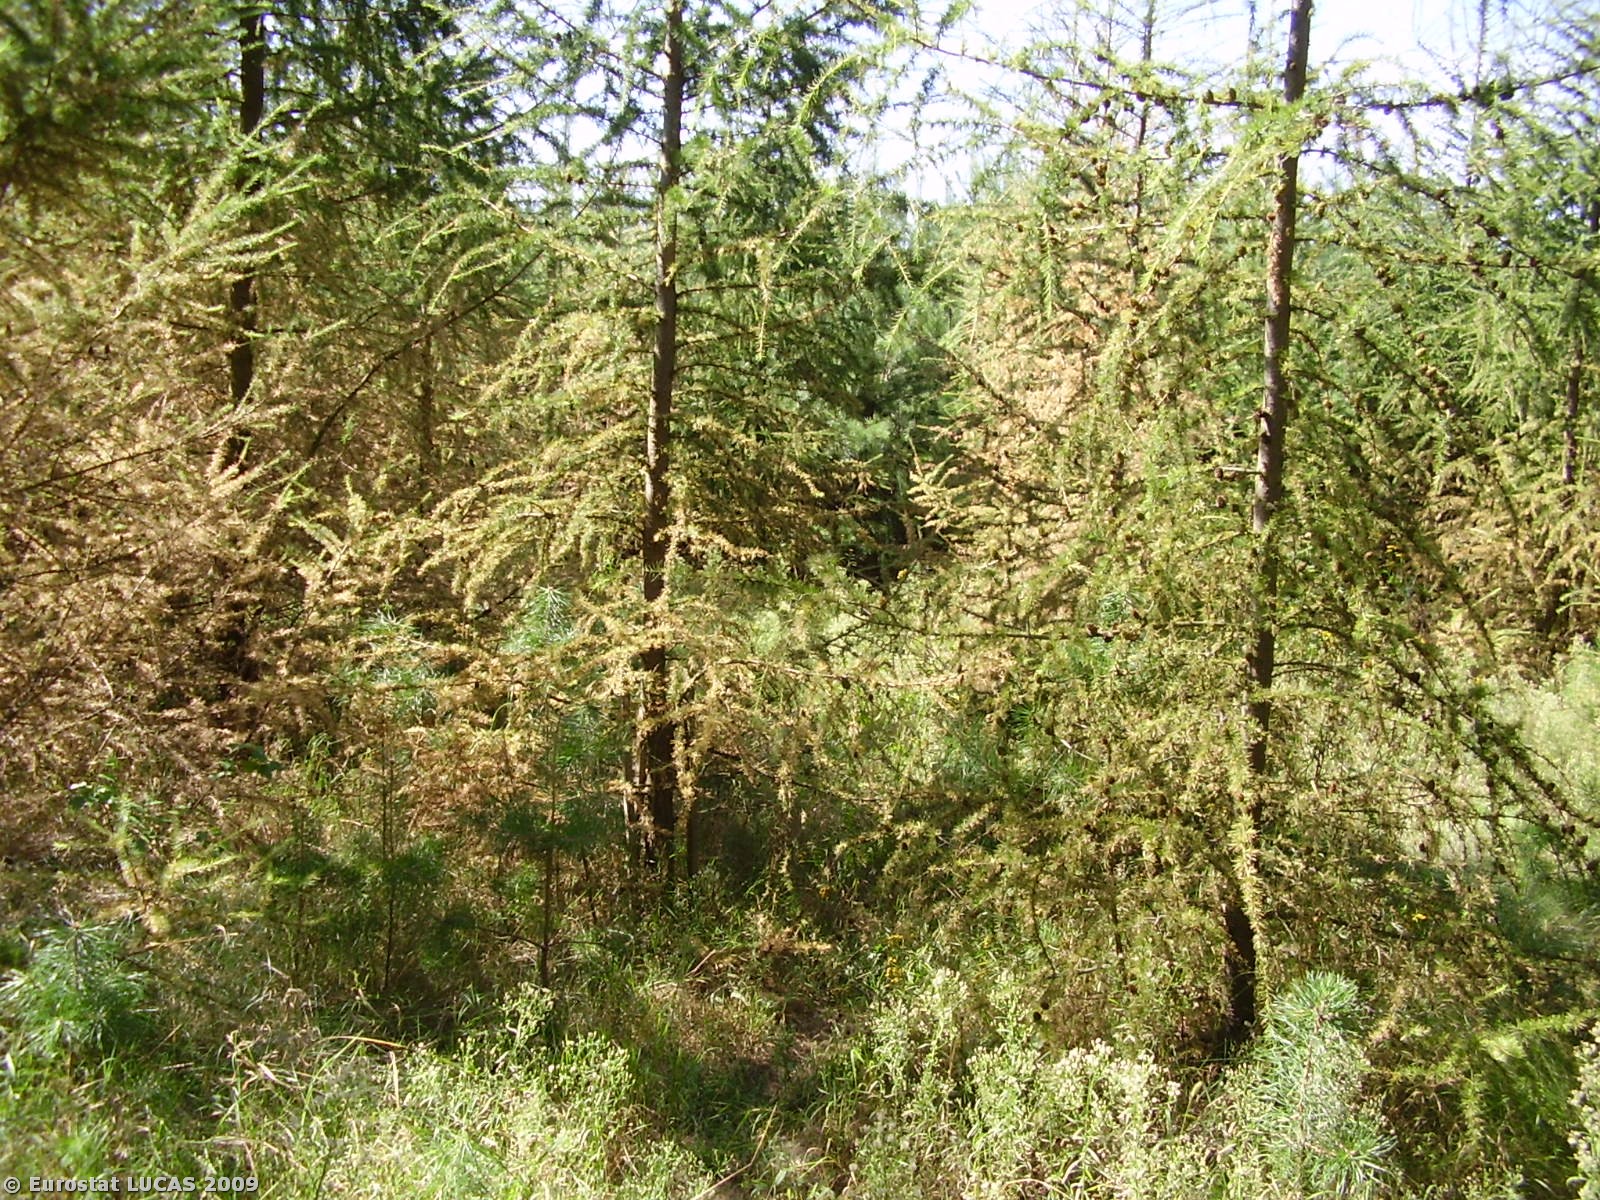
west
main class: Woodland
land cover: Coniferous woodland
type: hemiboreal forest and nemoral coniferous forest and mixed broadleaved-coniferous forest
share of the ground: > 75 %
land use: Forestry
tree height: > 5 m
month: August
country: PL
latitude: 51.3346
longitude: 16.7983
